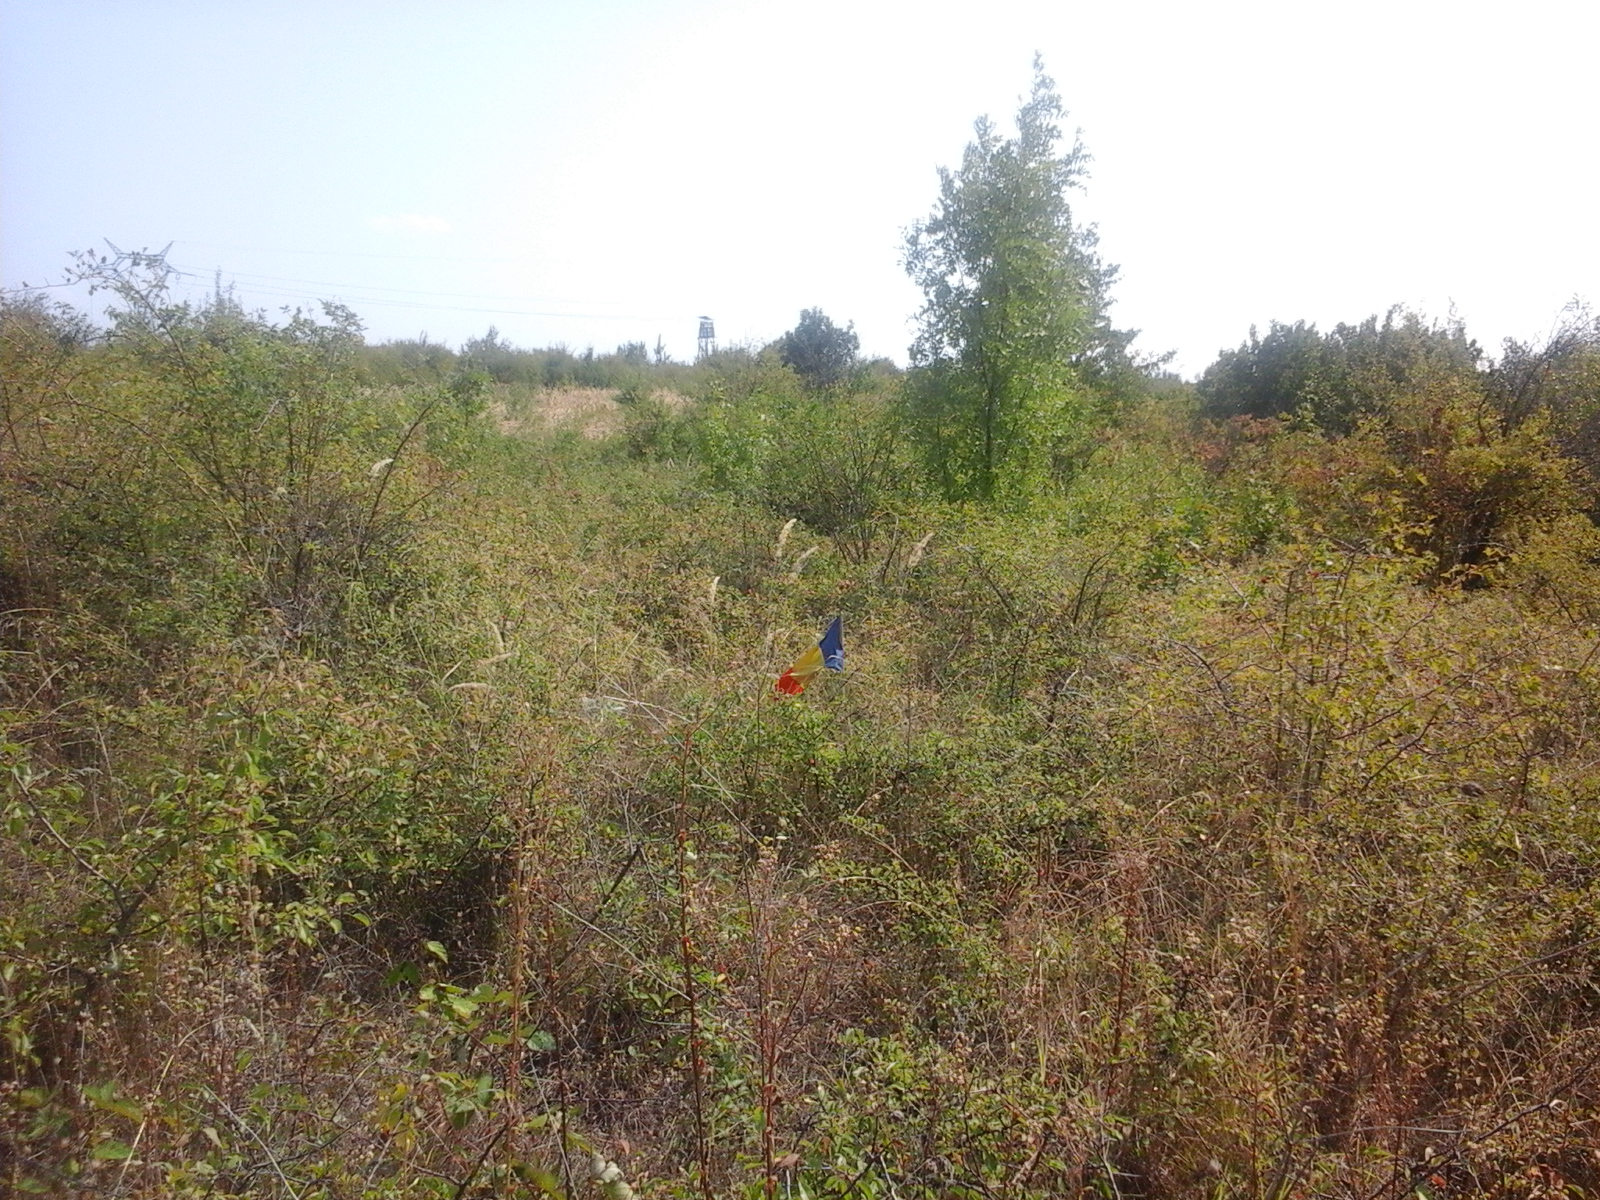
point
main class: Shrubland
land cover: Shrubland with sparse tree cover
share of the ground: > 75 %
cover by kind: shrubs 95 %, broadleaved forest trees 5 %
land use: Semi-natural and natural areas not in use
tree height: < 5 m
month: August
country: RO
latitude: 44.4788
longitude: 23.6975
